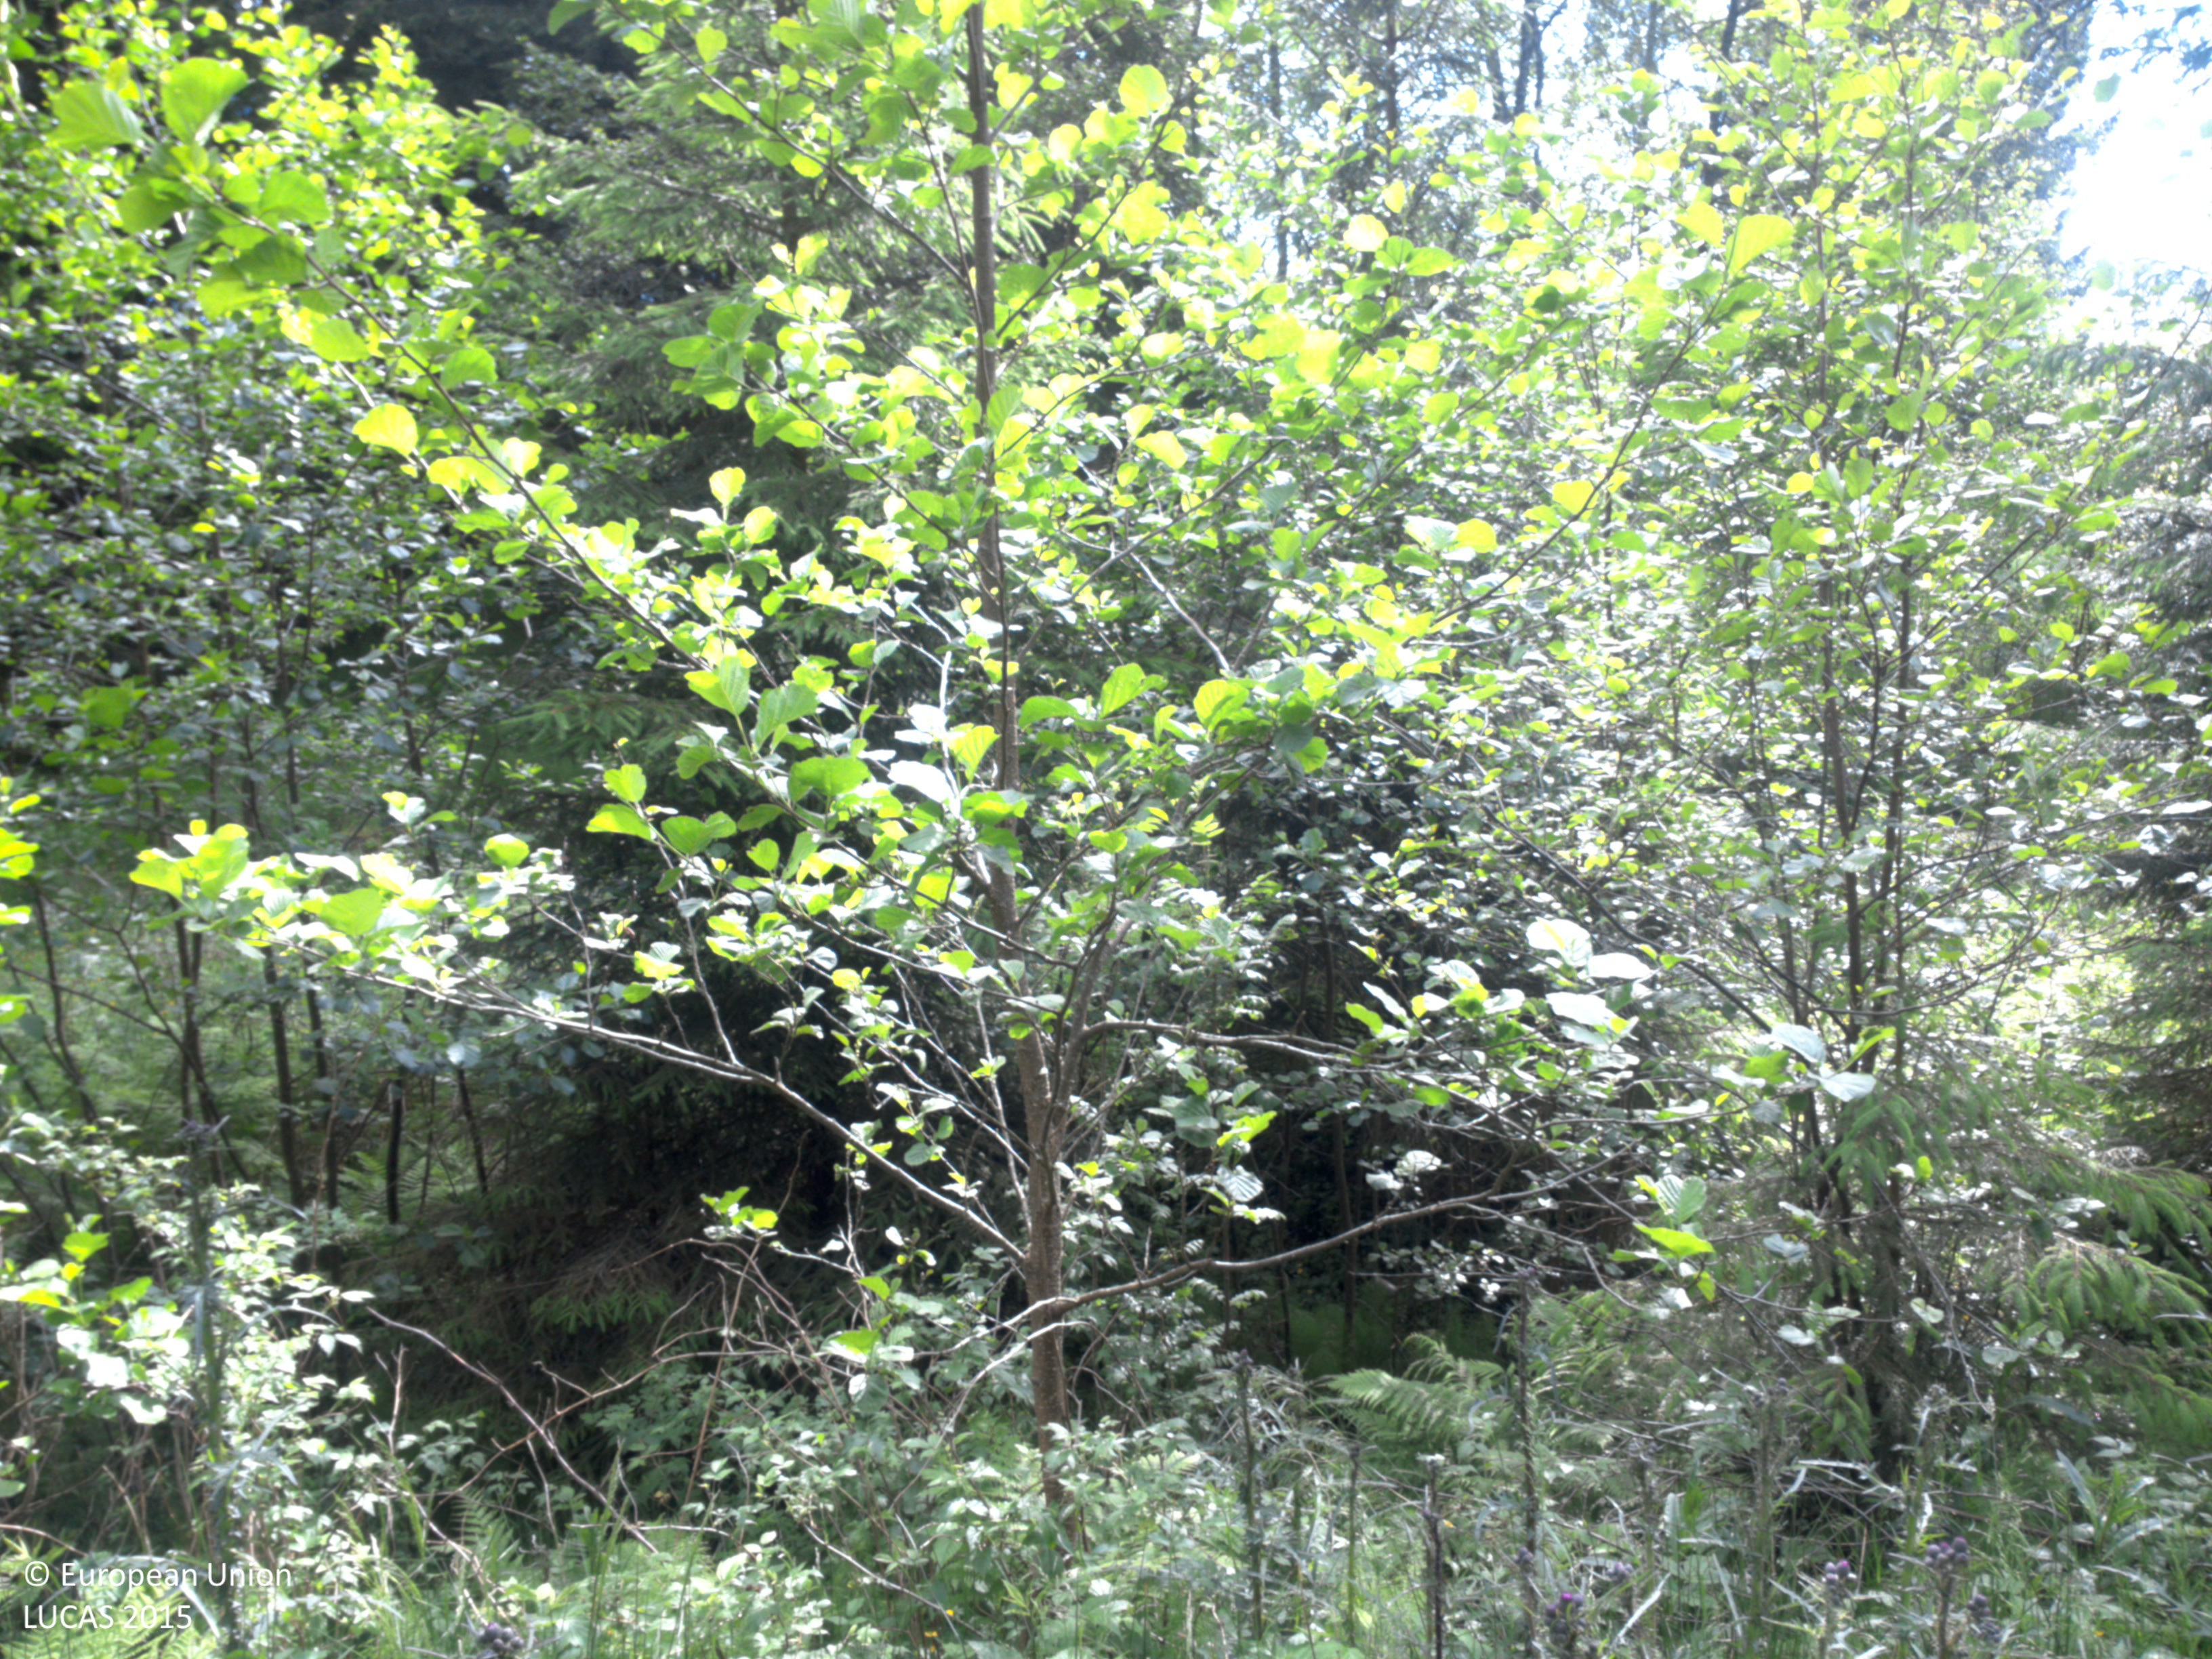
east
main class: Grassland
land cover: Grassland without tree/shrub cover
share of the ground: > 75 %
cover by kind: herbaceous plants 100 %
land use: Abandoned areas
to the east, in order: Grassland without tree/shrub cover; Broadleaved woodland; Ditches and canals; Grassland with sparse tree/shrub cover; Spruce dominated mixed woodland; Spruce dominated coniferous woodland; Grassland without tree/shrub cover; Spruce dominated coniferous woodland; Tracks; Spruce dominated coniferous woodland; Tracks; Spruce dominated coniferous woodland; Grassland with sparse tree/shrub cover; Broadleaved woodland
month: June
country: SE
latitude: 58.6965
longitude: 11.5323
